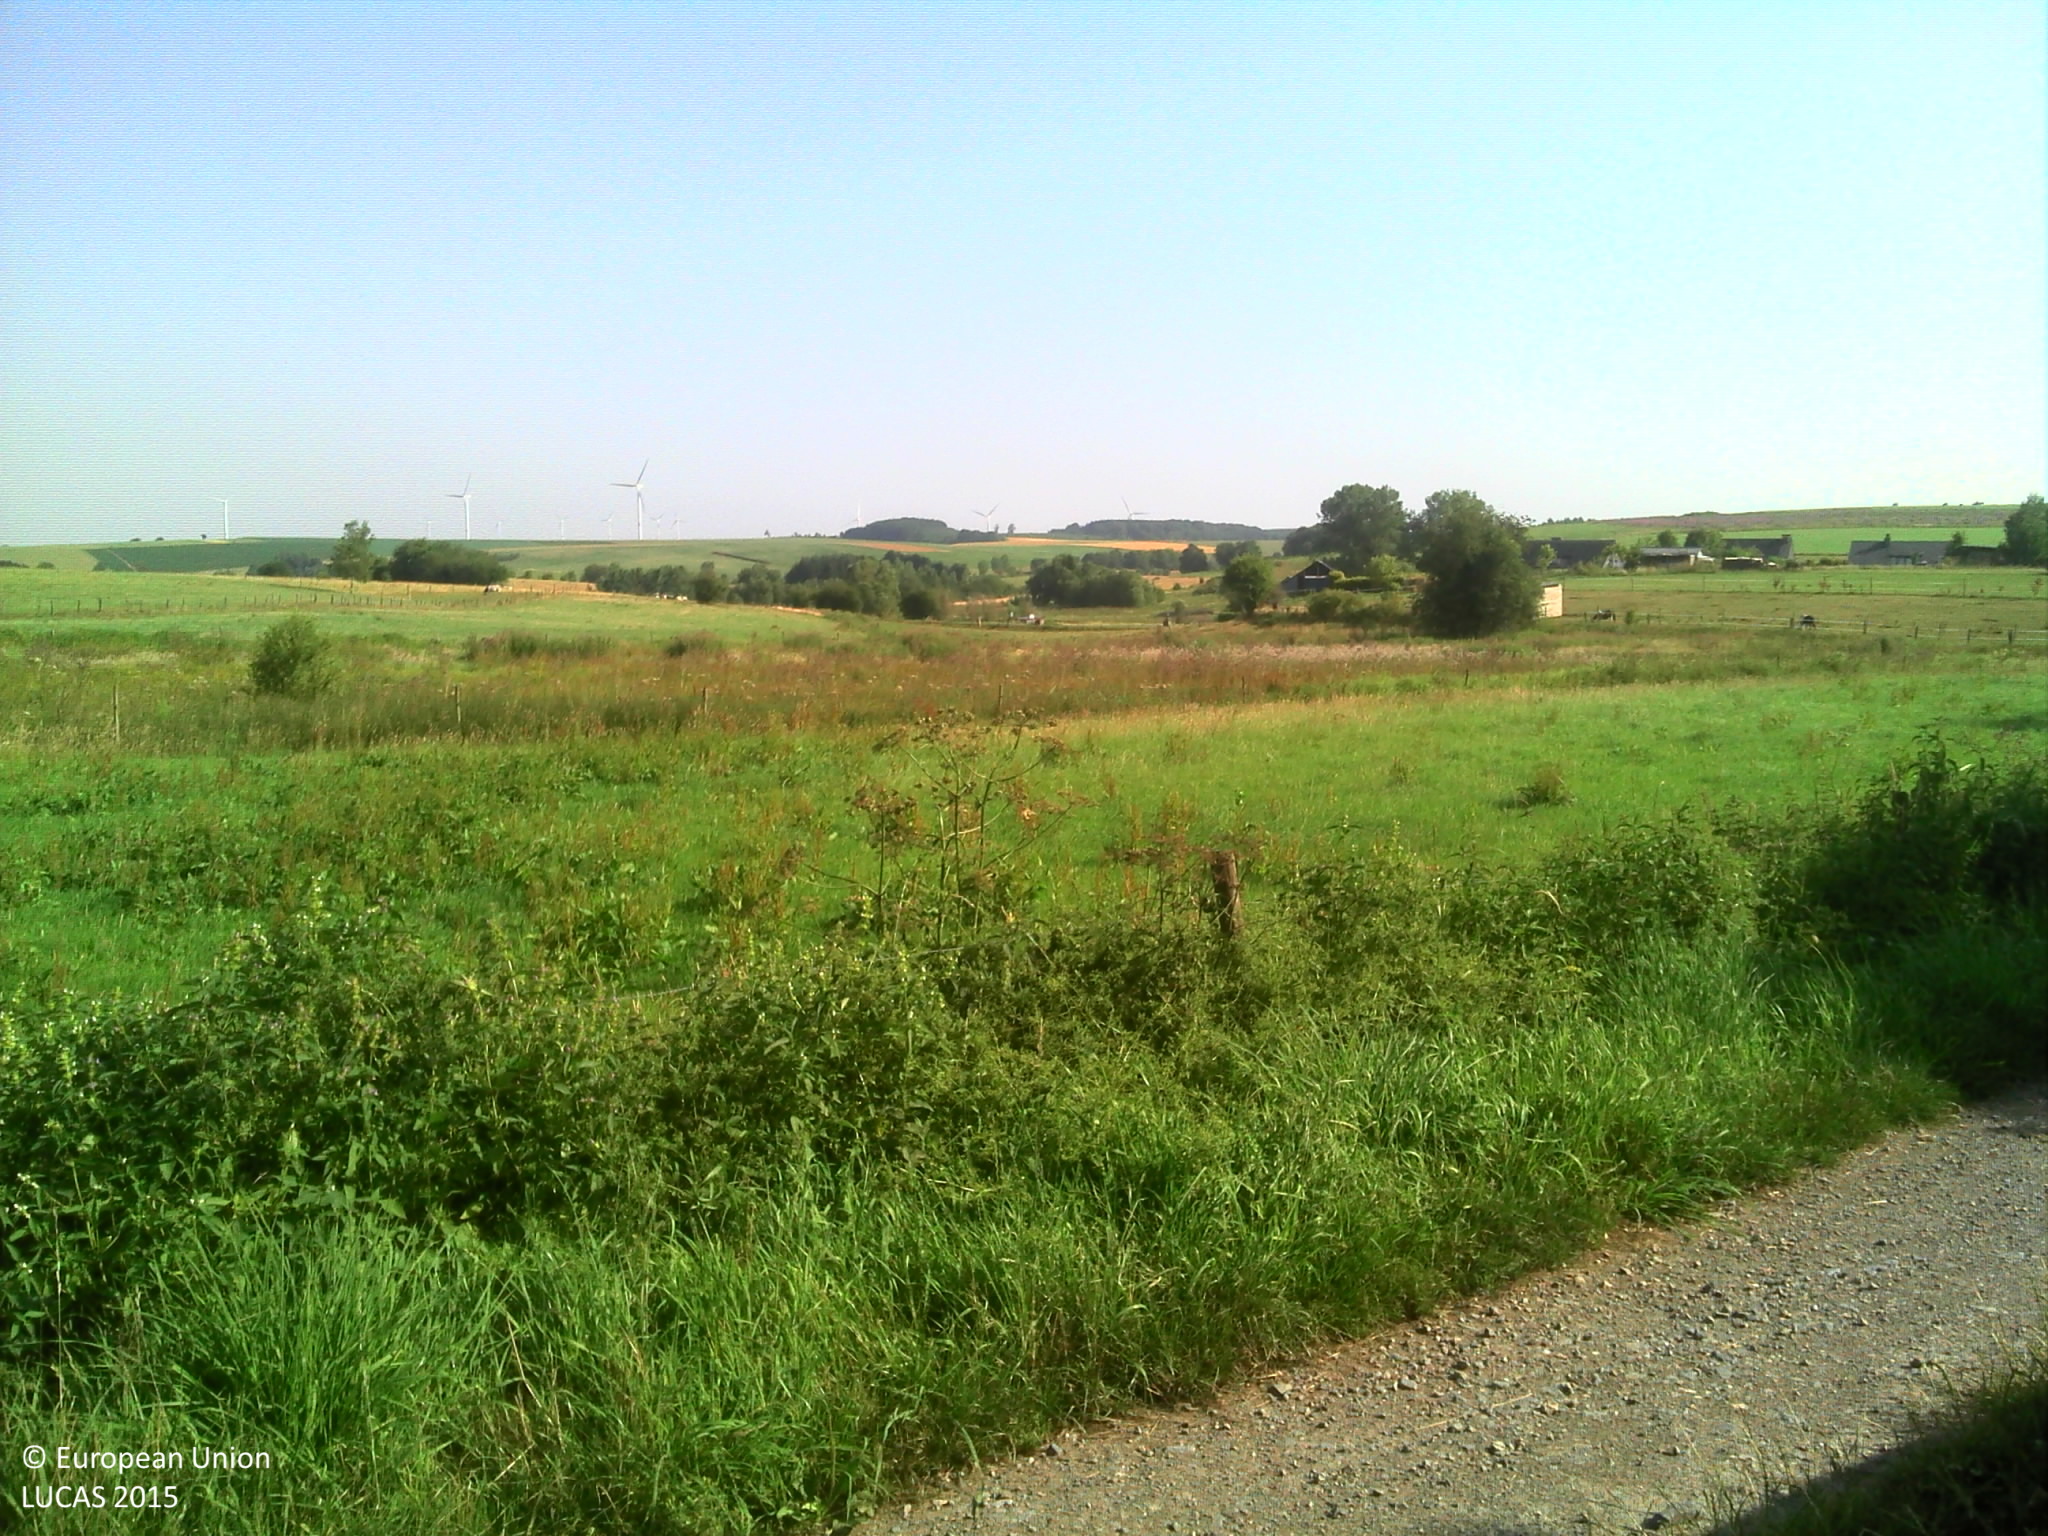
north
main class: Grassland
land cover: Grassland without tree/shrub cover
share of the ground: > 75 %
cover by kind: herbaceous plants 100 %
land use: Residential
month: July
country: BE
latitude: 49.9735
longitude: 5.6063
